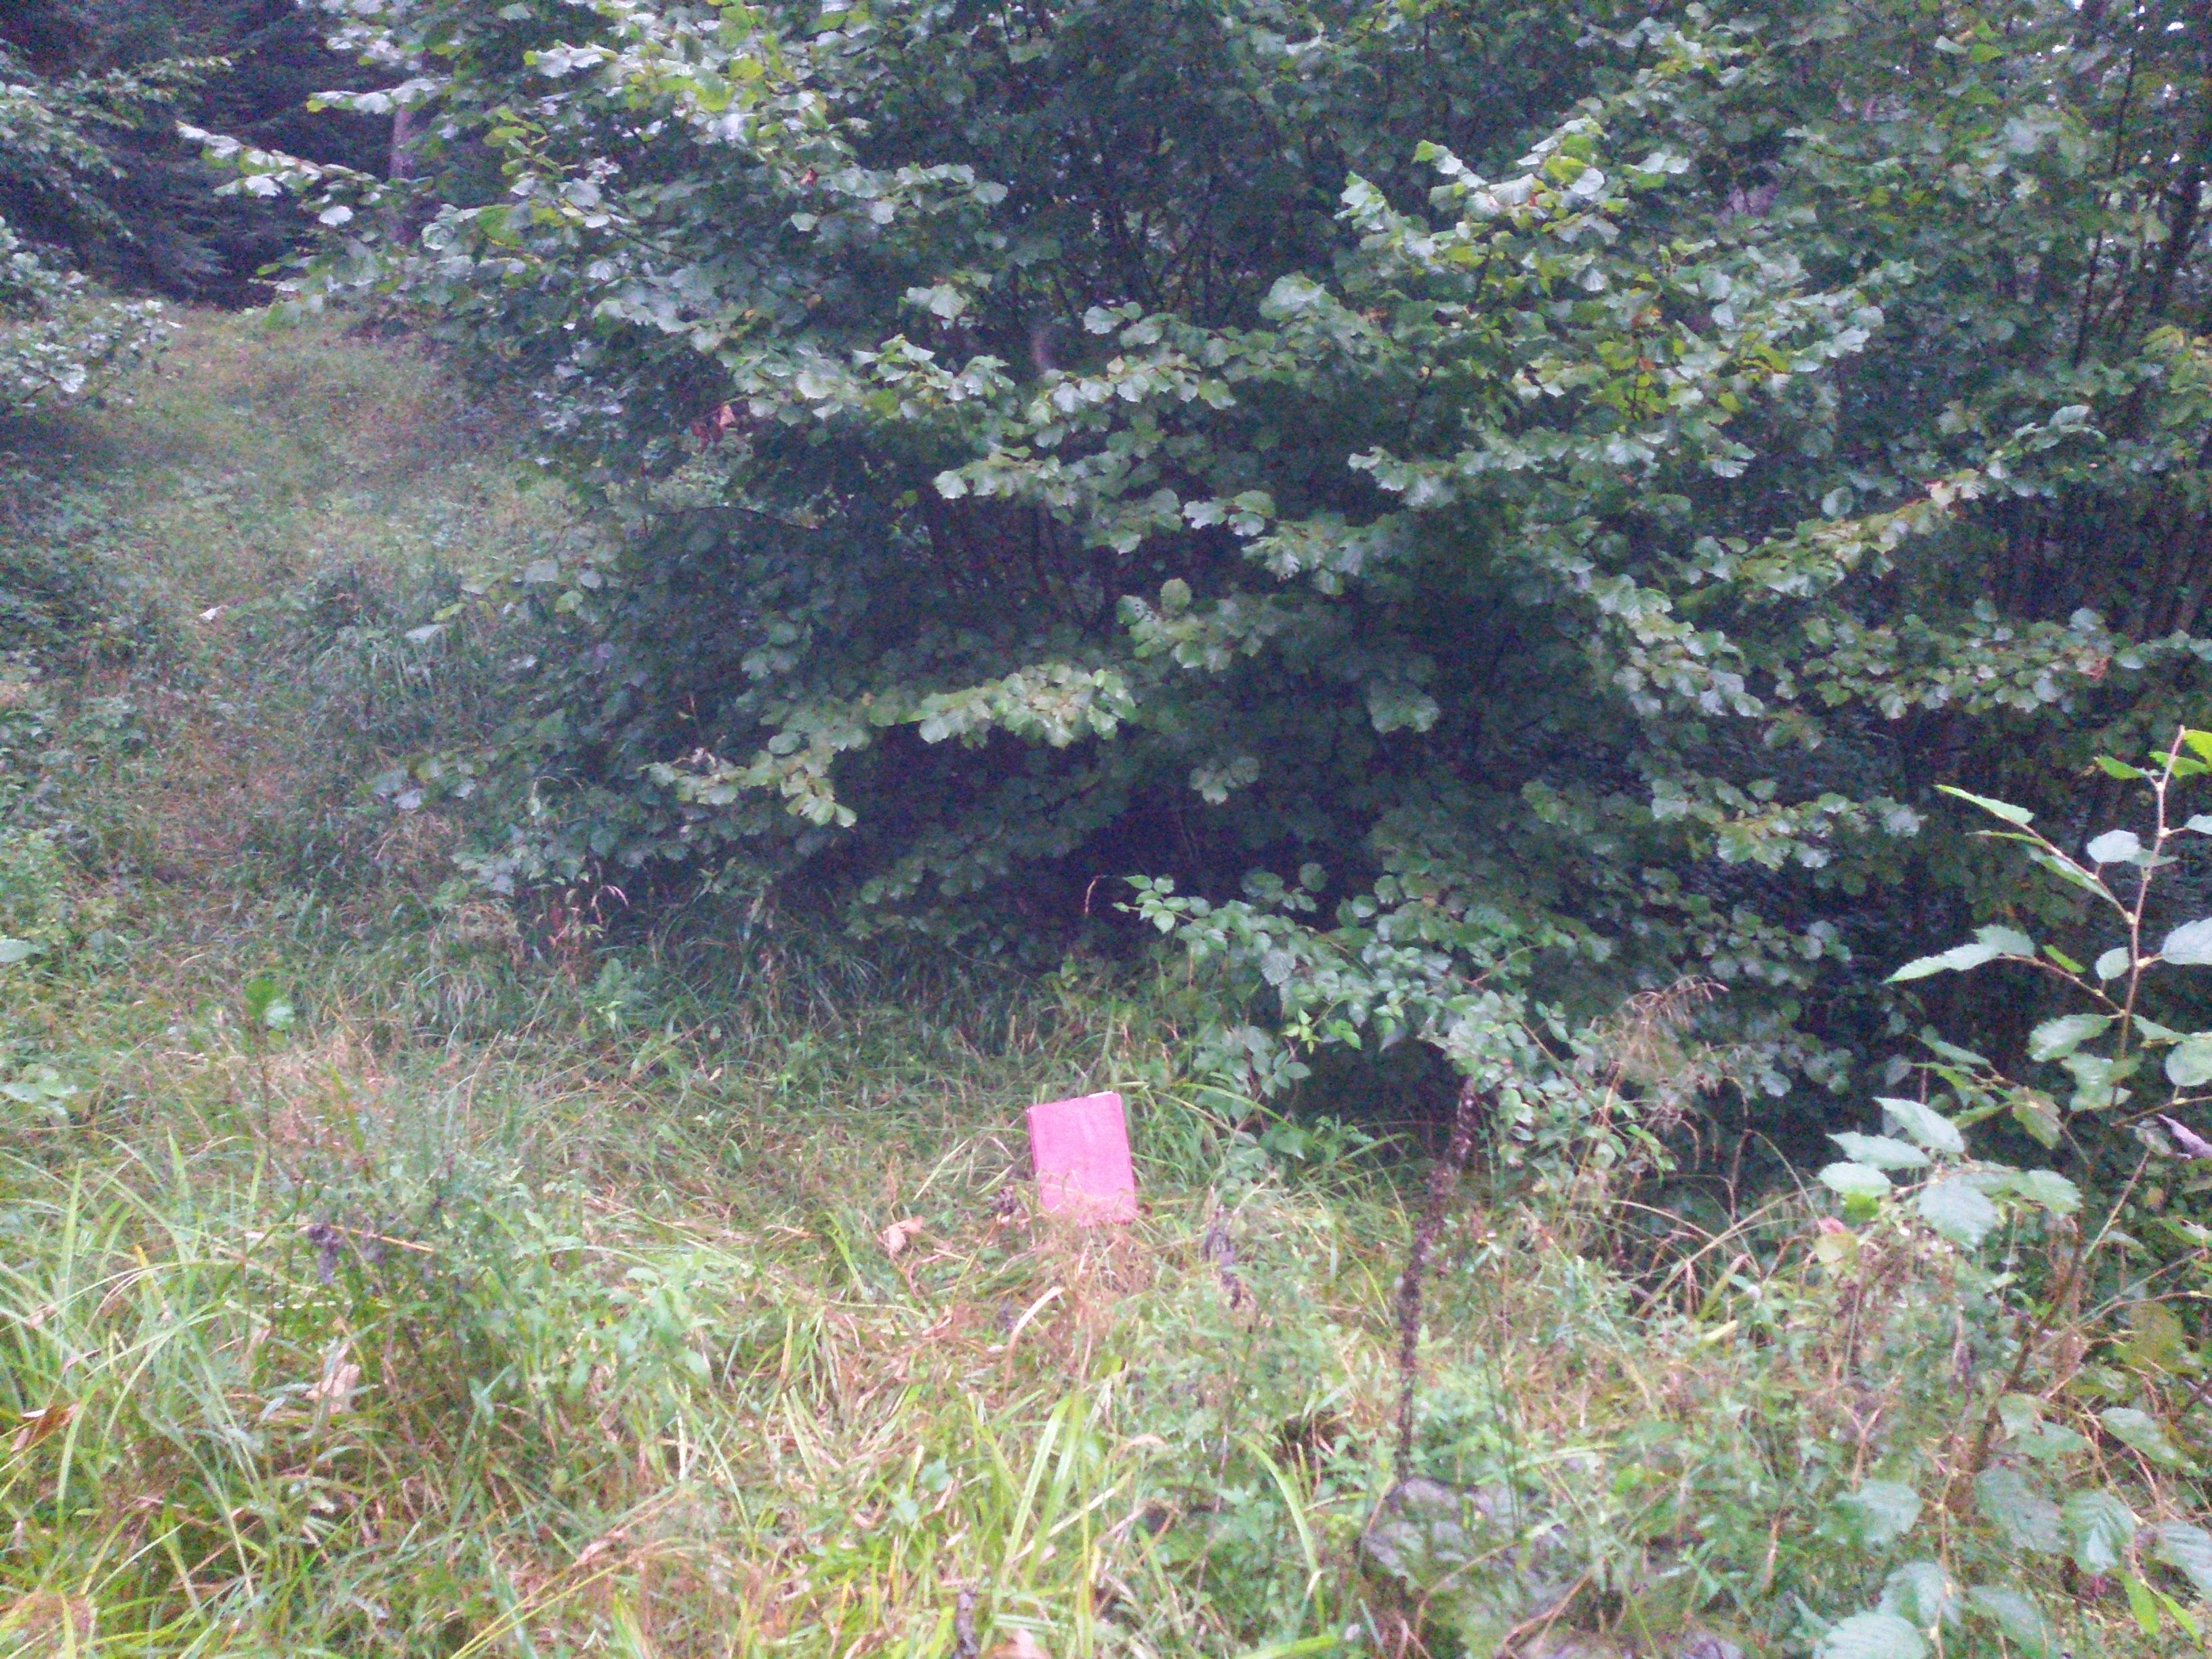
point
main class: Woodland
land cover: Other mixed woodland
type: hemiboreal forest and nemoral coniferous forest and mixed broadleaved-coniferous forest
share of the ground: > 75 %
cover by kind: broadleaved forest trees 50 %, coniferous forest trees 25 %, herbaceous plants 20 %, shrubs 5 %
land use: Forestry
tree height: > 5 m
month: September
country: PL
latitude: 49.5477
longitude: 21.4796
